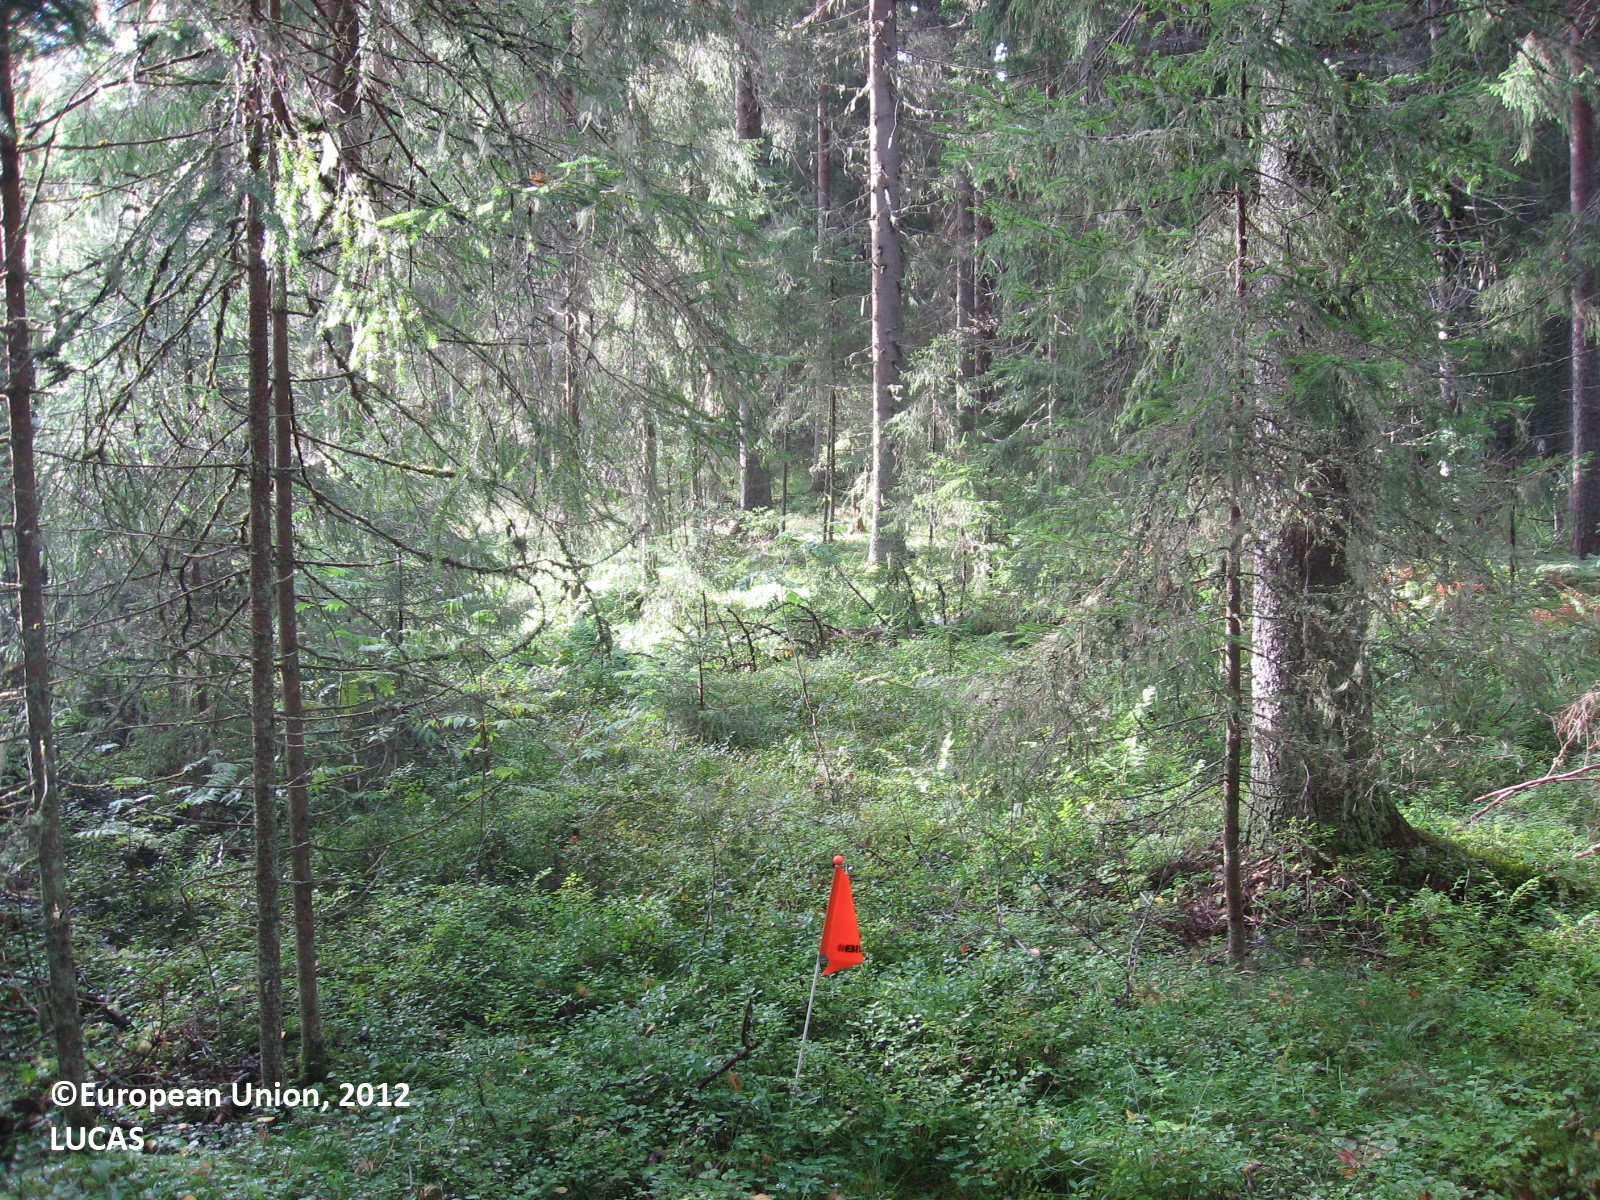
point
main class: Woodland
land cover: Spruce dominated coniferous woodland
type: boreal forest
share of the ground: > 75 %
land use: Forestry
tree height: > 5 m
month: August
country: FI
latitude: 61.5792
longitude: 24.8144
